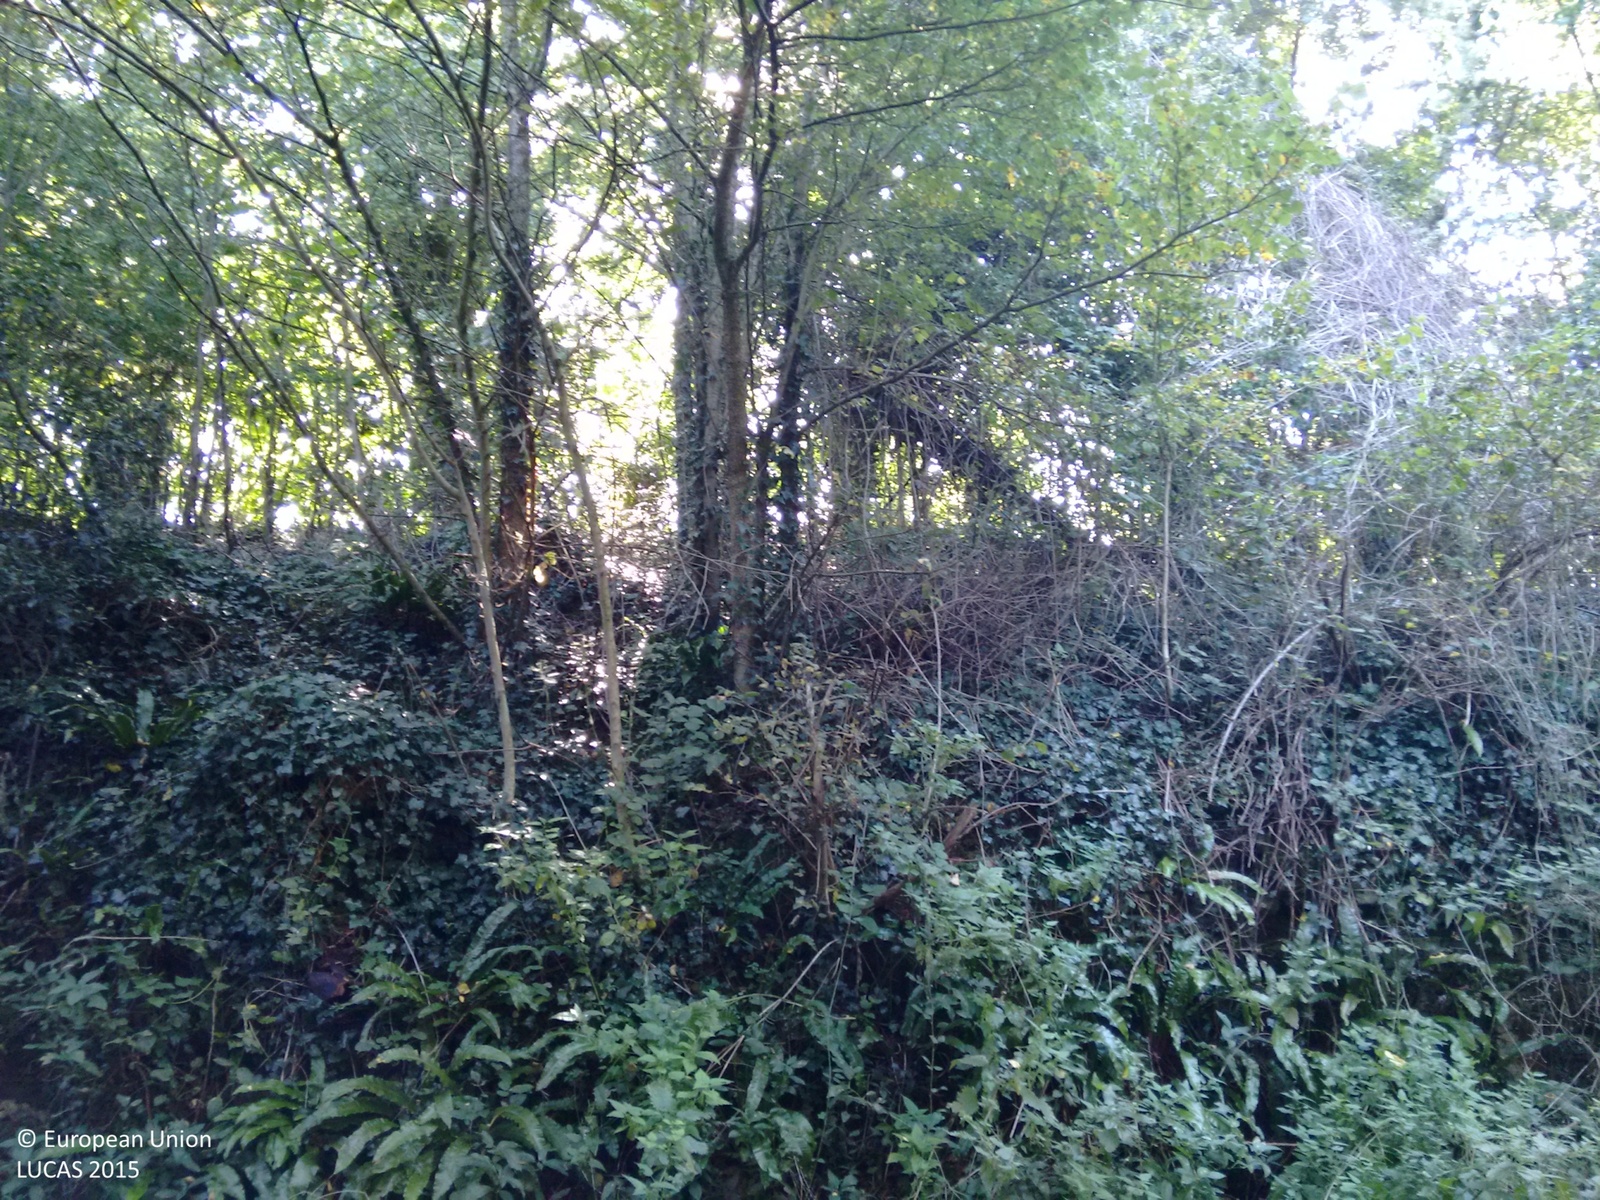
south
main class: Woodland
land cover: Broadleaved woodland
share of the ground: > 75 %
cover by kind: broadleaved forest trees 80 %, shrubs 20 %
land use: Residential
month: September
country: GB
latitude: 51.6014
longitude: -2.5266
